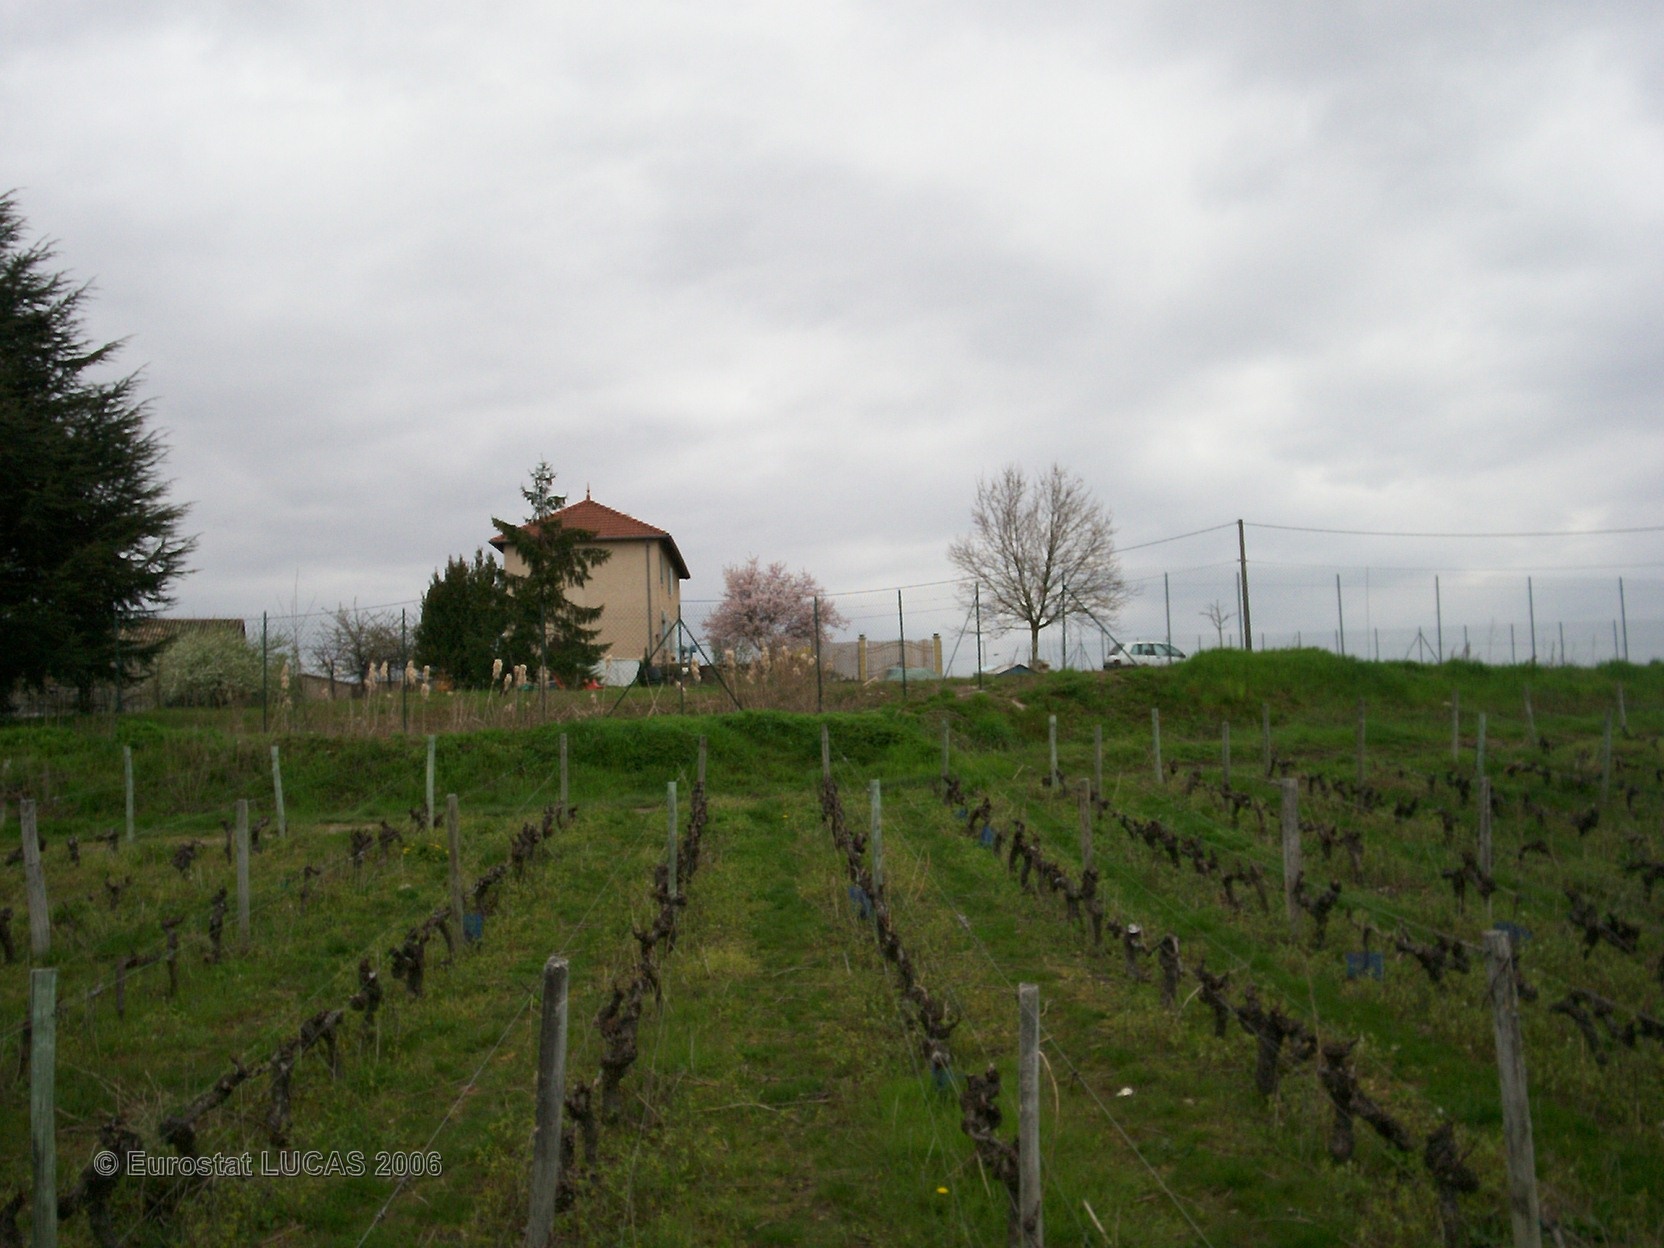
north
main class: Cropland
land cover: Vineyards
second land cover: Grassland without tree/shrub cover
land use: Agriculture (excluding fallow land and kitchen gardens)
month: April
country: FR
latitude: 46.1300
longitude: 4.7089
